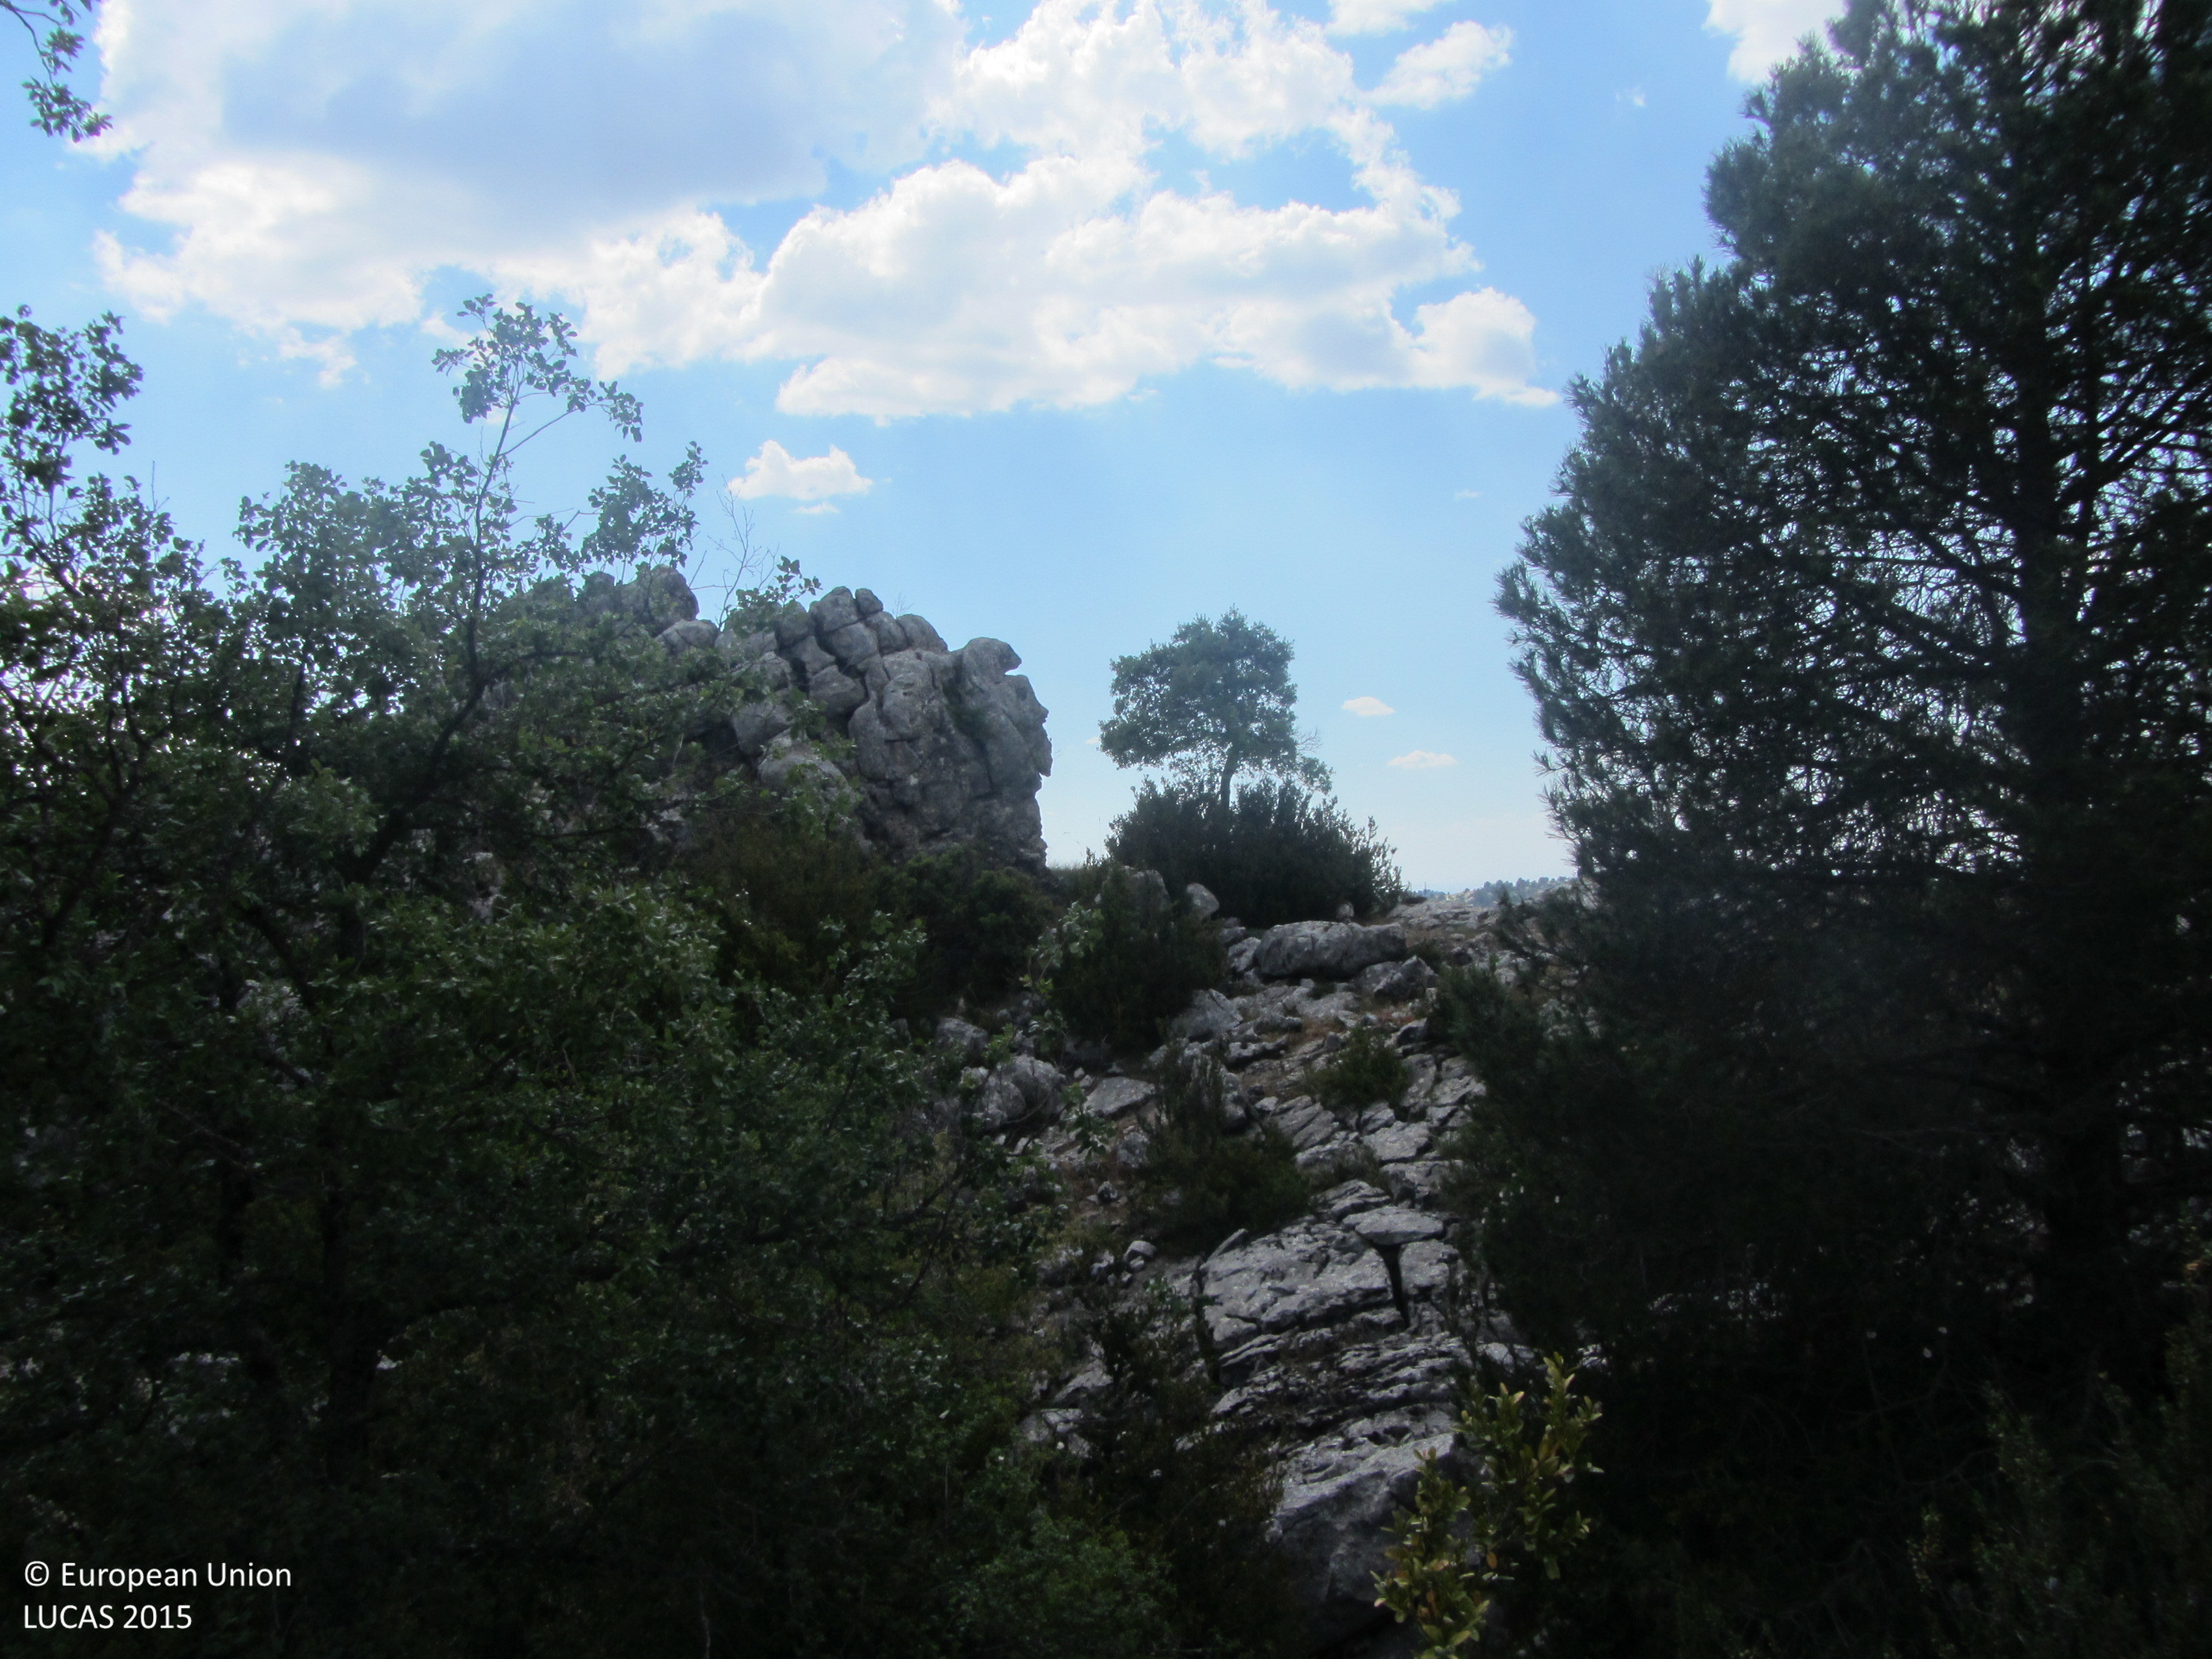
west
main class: Woodland
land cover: Pine dominated mixed woodland
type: coniferous forest of the mediterranean region
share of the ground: 50 - 75 %
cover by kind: consolidated bare surface 30 %, coniferous forest trees 25 %, broadleaved forest trees 25 %, shrubs 20 %
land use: Semi-natural and natural areas not in use
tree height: > 5 m
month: May
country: ES
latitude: 38.0555
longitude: -2.9087
